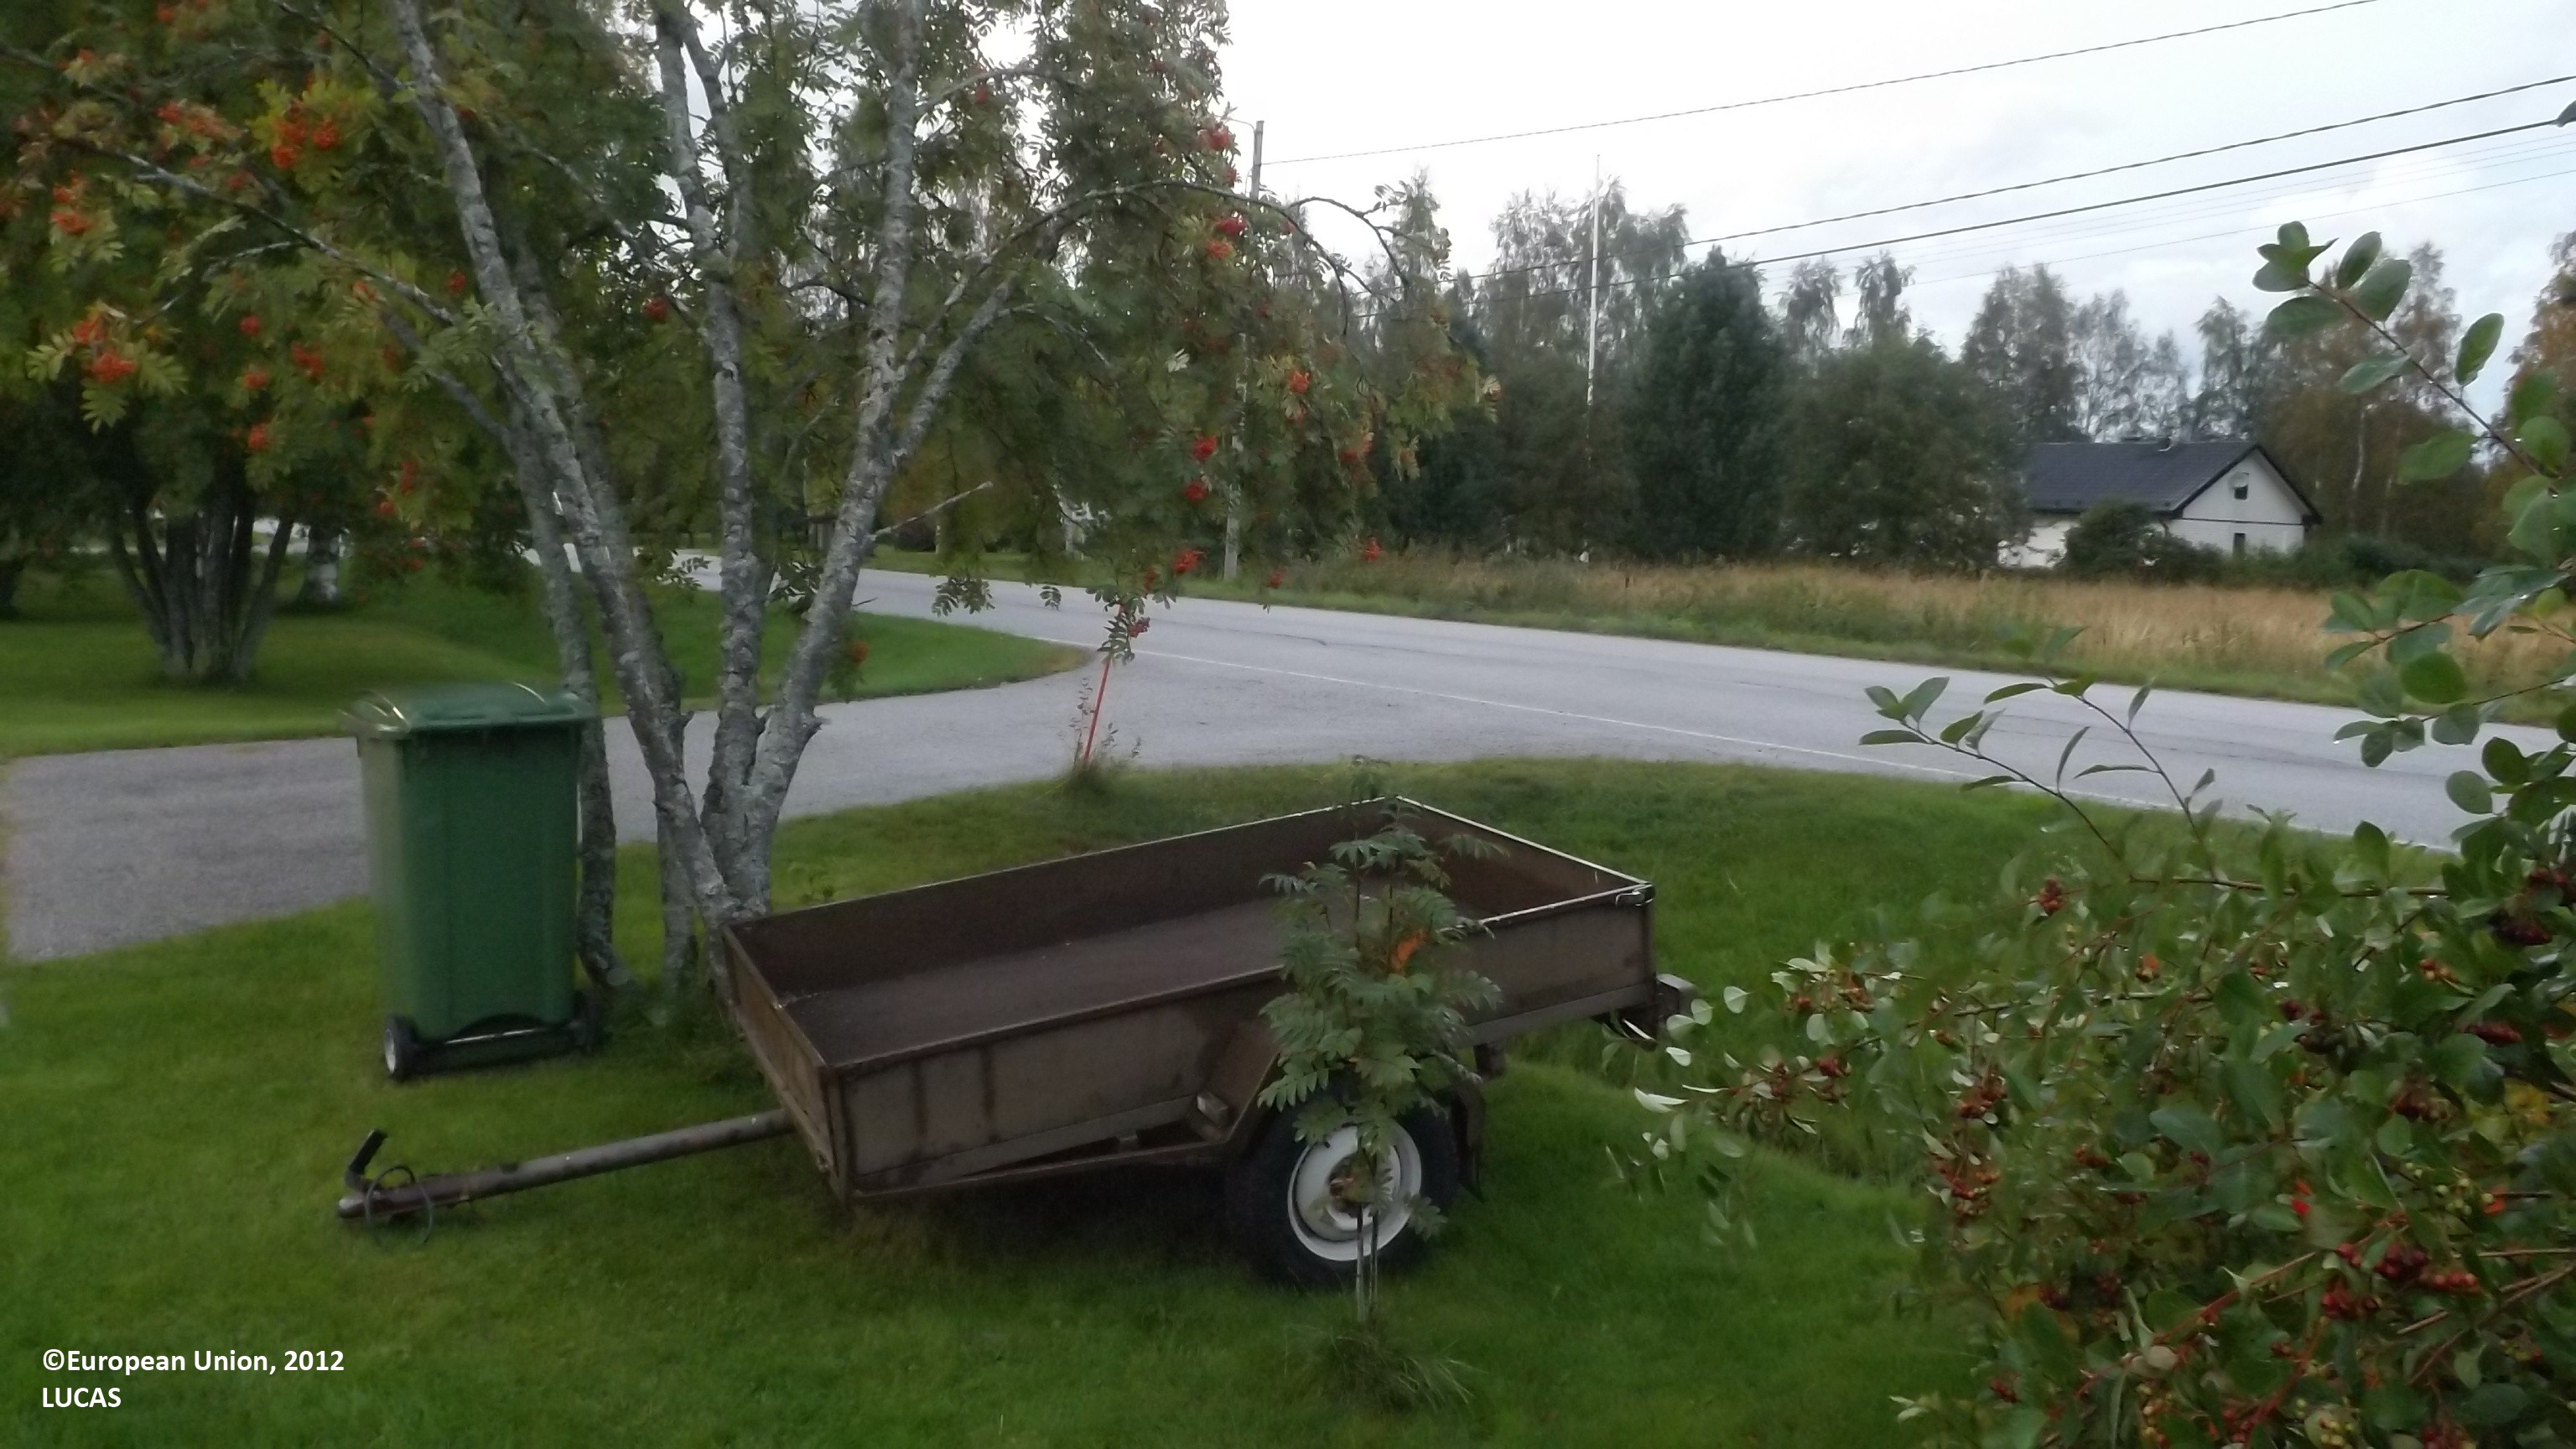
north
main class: Grassland
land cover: Grassland with sparse tree/shrub cover
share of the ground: 10 - 25 %
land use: Residential
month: August
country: FI
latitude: 63.9111
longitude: 23.9034
